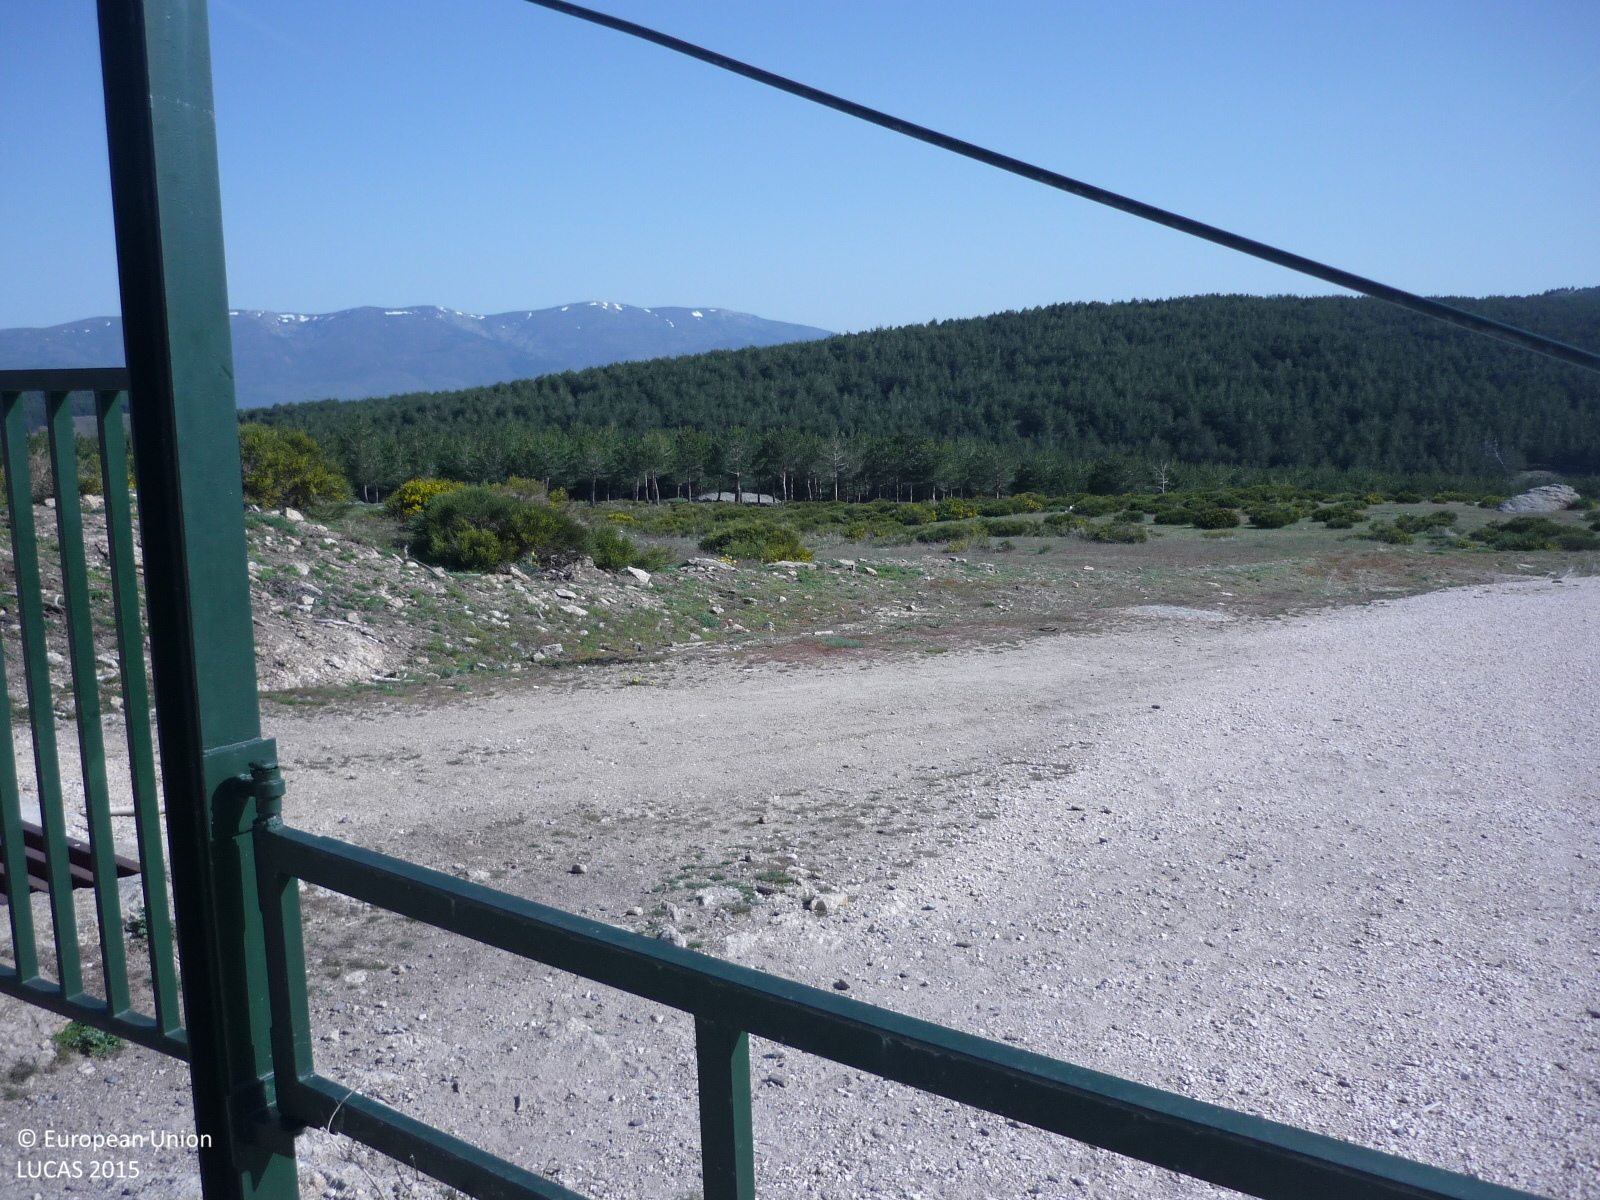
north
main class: Shrubland
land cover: Shrubland with sparse tree cover
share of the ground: 25 - 50 %
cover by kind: herbaceous plants 55 %, shrubs 35 %, coniferous forest trees 5 %, unconsolidated bare surface 5 %
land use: Semi-natural and natural areas not in use
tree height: < 5 m
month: May
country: ES
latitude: 40.8598
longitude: -3.8182
